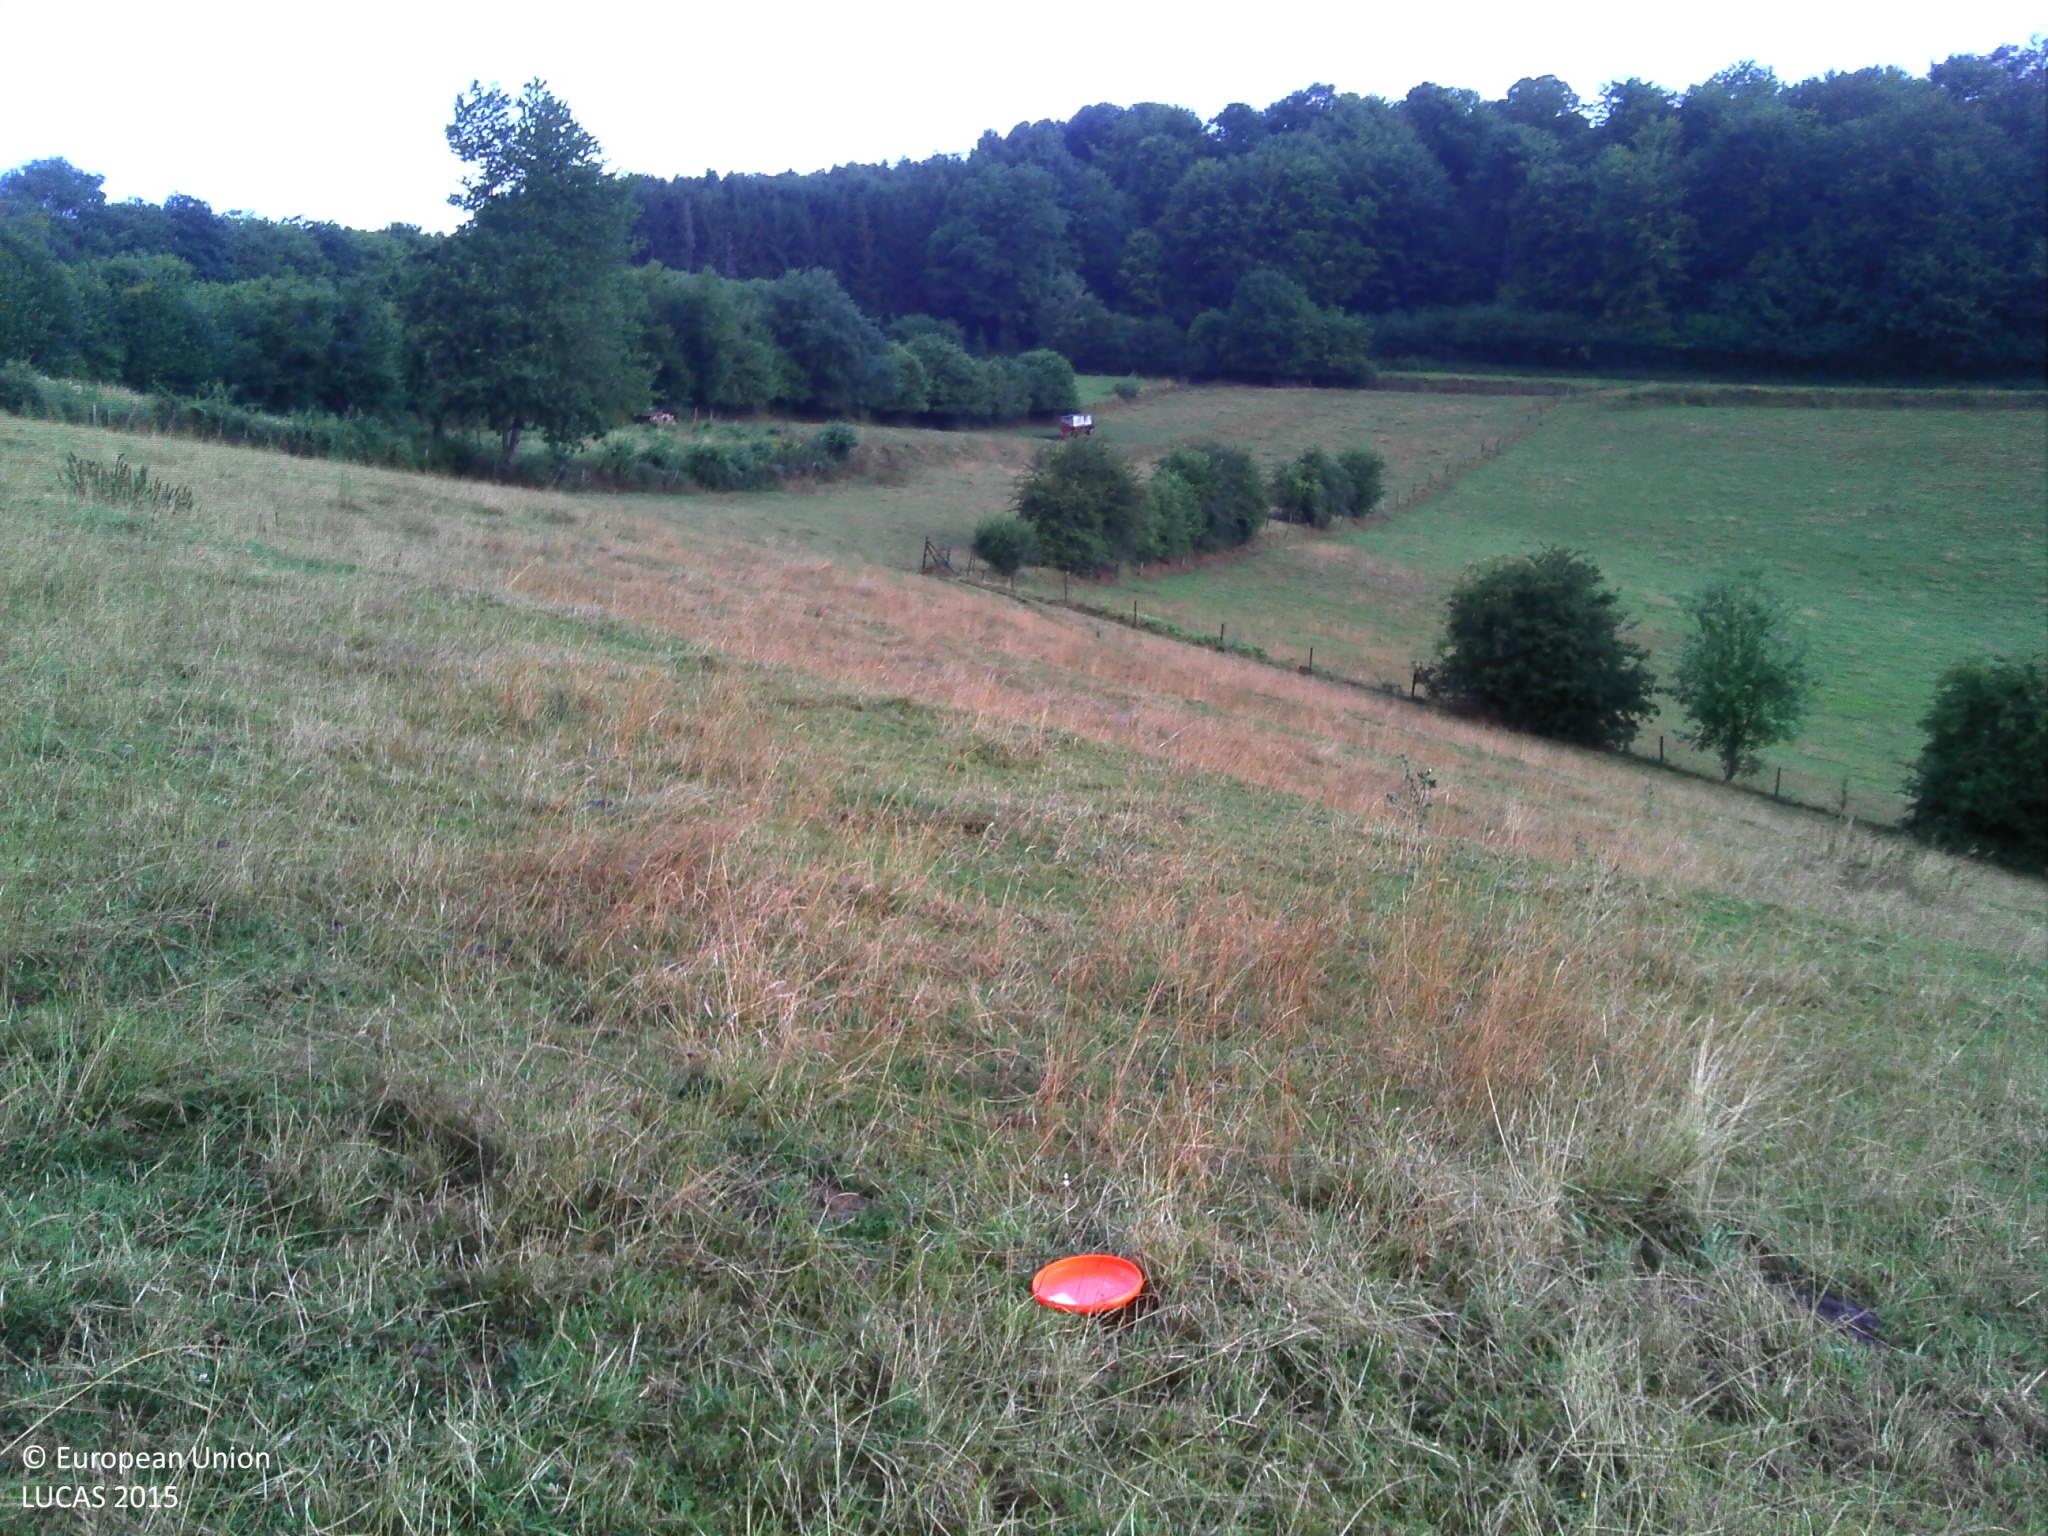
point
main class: Grassland
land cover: Grassland without tree/shrub cover
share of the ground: > 75 %
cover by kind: herbaceous plants 100 %
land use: Agriculture (excluding fallow land and kitchen gardens)
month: July
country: BE
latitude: 49.6019
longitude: 5.7787
